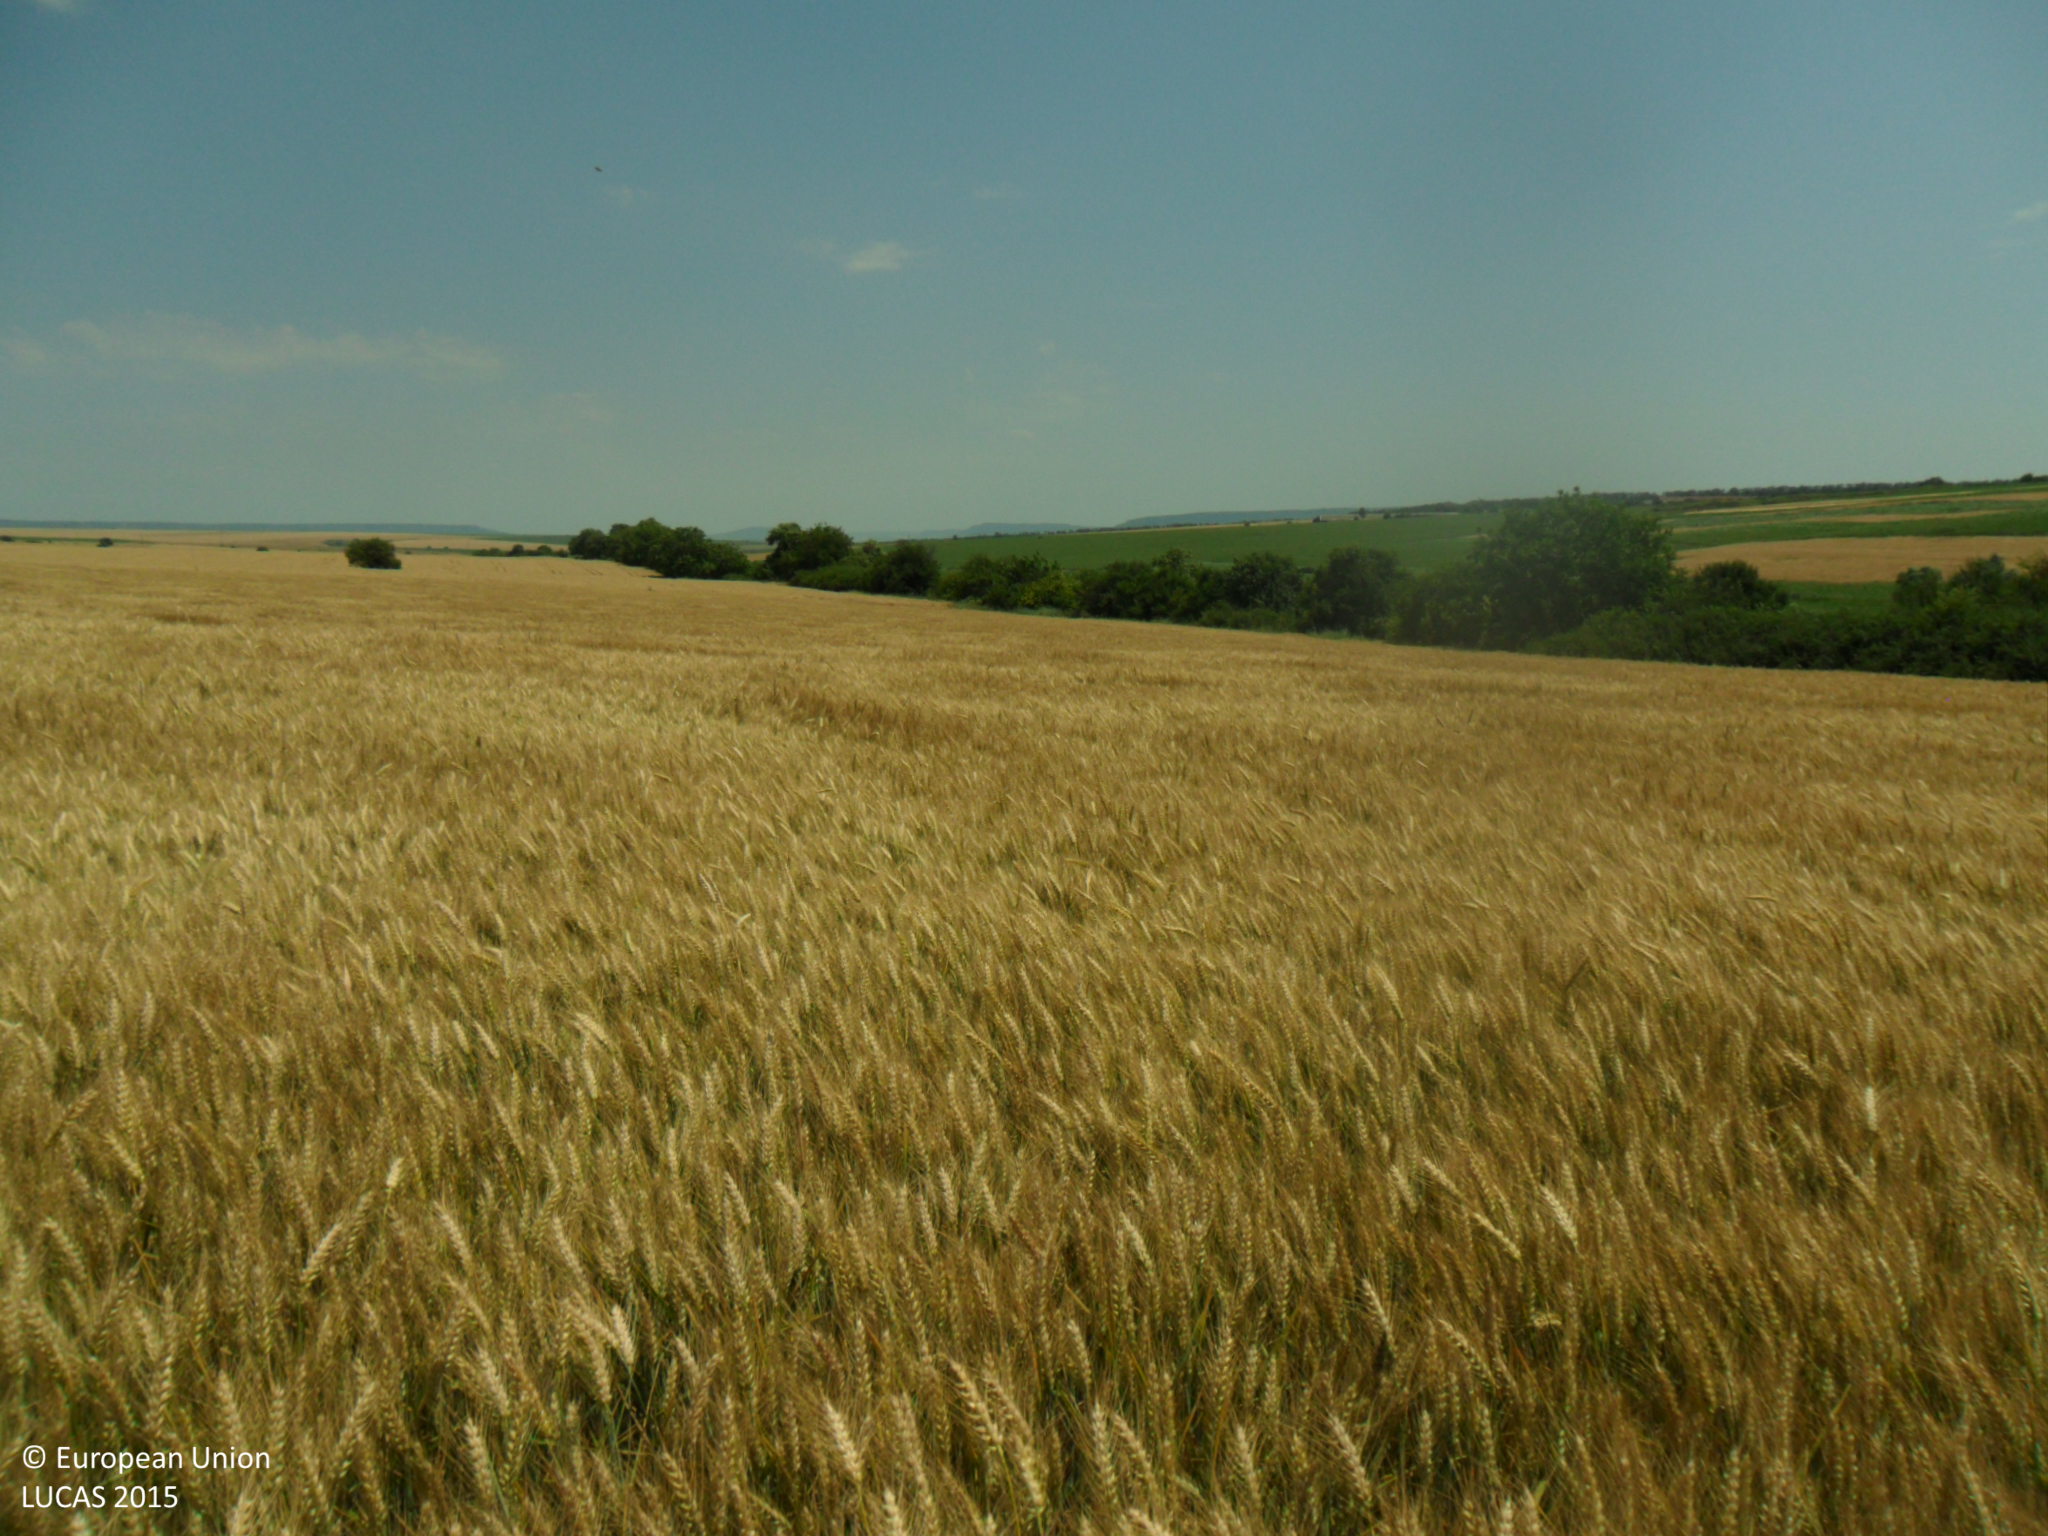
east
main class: Cropland
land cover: Common wheat
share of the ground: > 75 %
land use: Agriculture (excluding fallow land and kitchen gardens)
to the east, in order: Common wheat; Grass margins; Common wheat
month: June
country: BG
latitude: 43.3789
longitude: 26.9883
